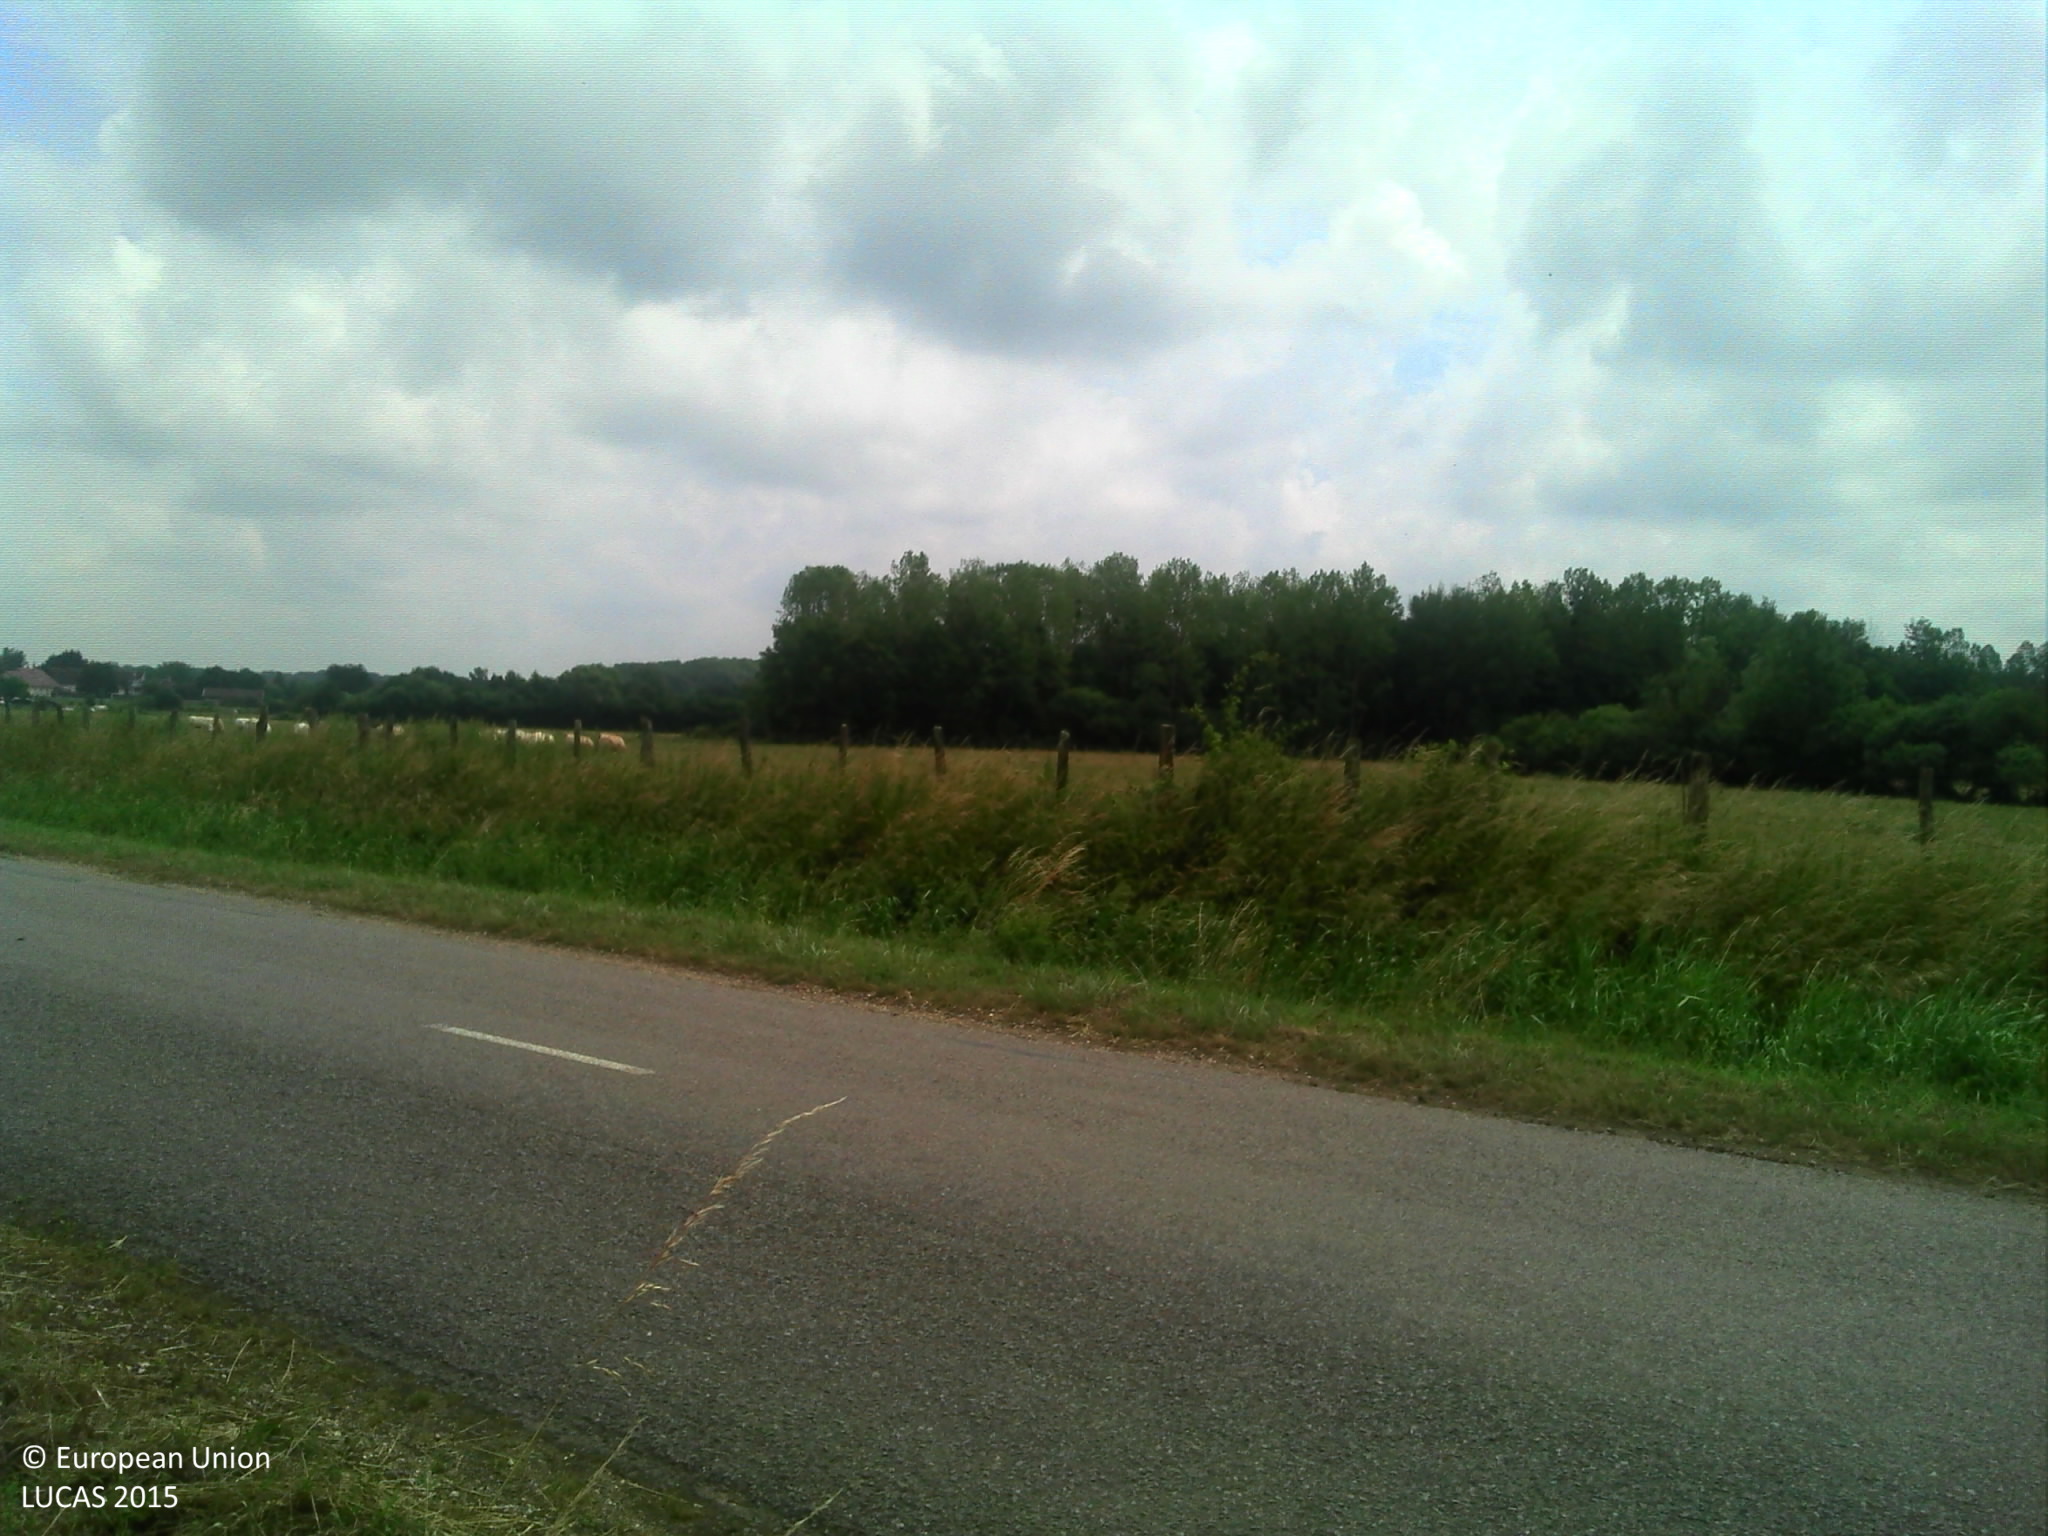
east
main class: Grassland
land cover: Grassland without tree/shrub cover
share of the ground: > 75 %
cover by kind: herbaceous plants 95 %, shrubs 5 %
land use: Agriculture (excluding fallow land and kitchen gardens)
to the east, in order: Grassland without tree/shrub cover; Fences; Grass margins; Paved roads, cycling and walking lanes; Grass margins; Rivers and streams; Grass margins; Fences; Grassland without tree/shrub cover
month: June
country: FR
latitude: 47.2640
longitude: 5.4416
